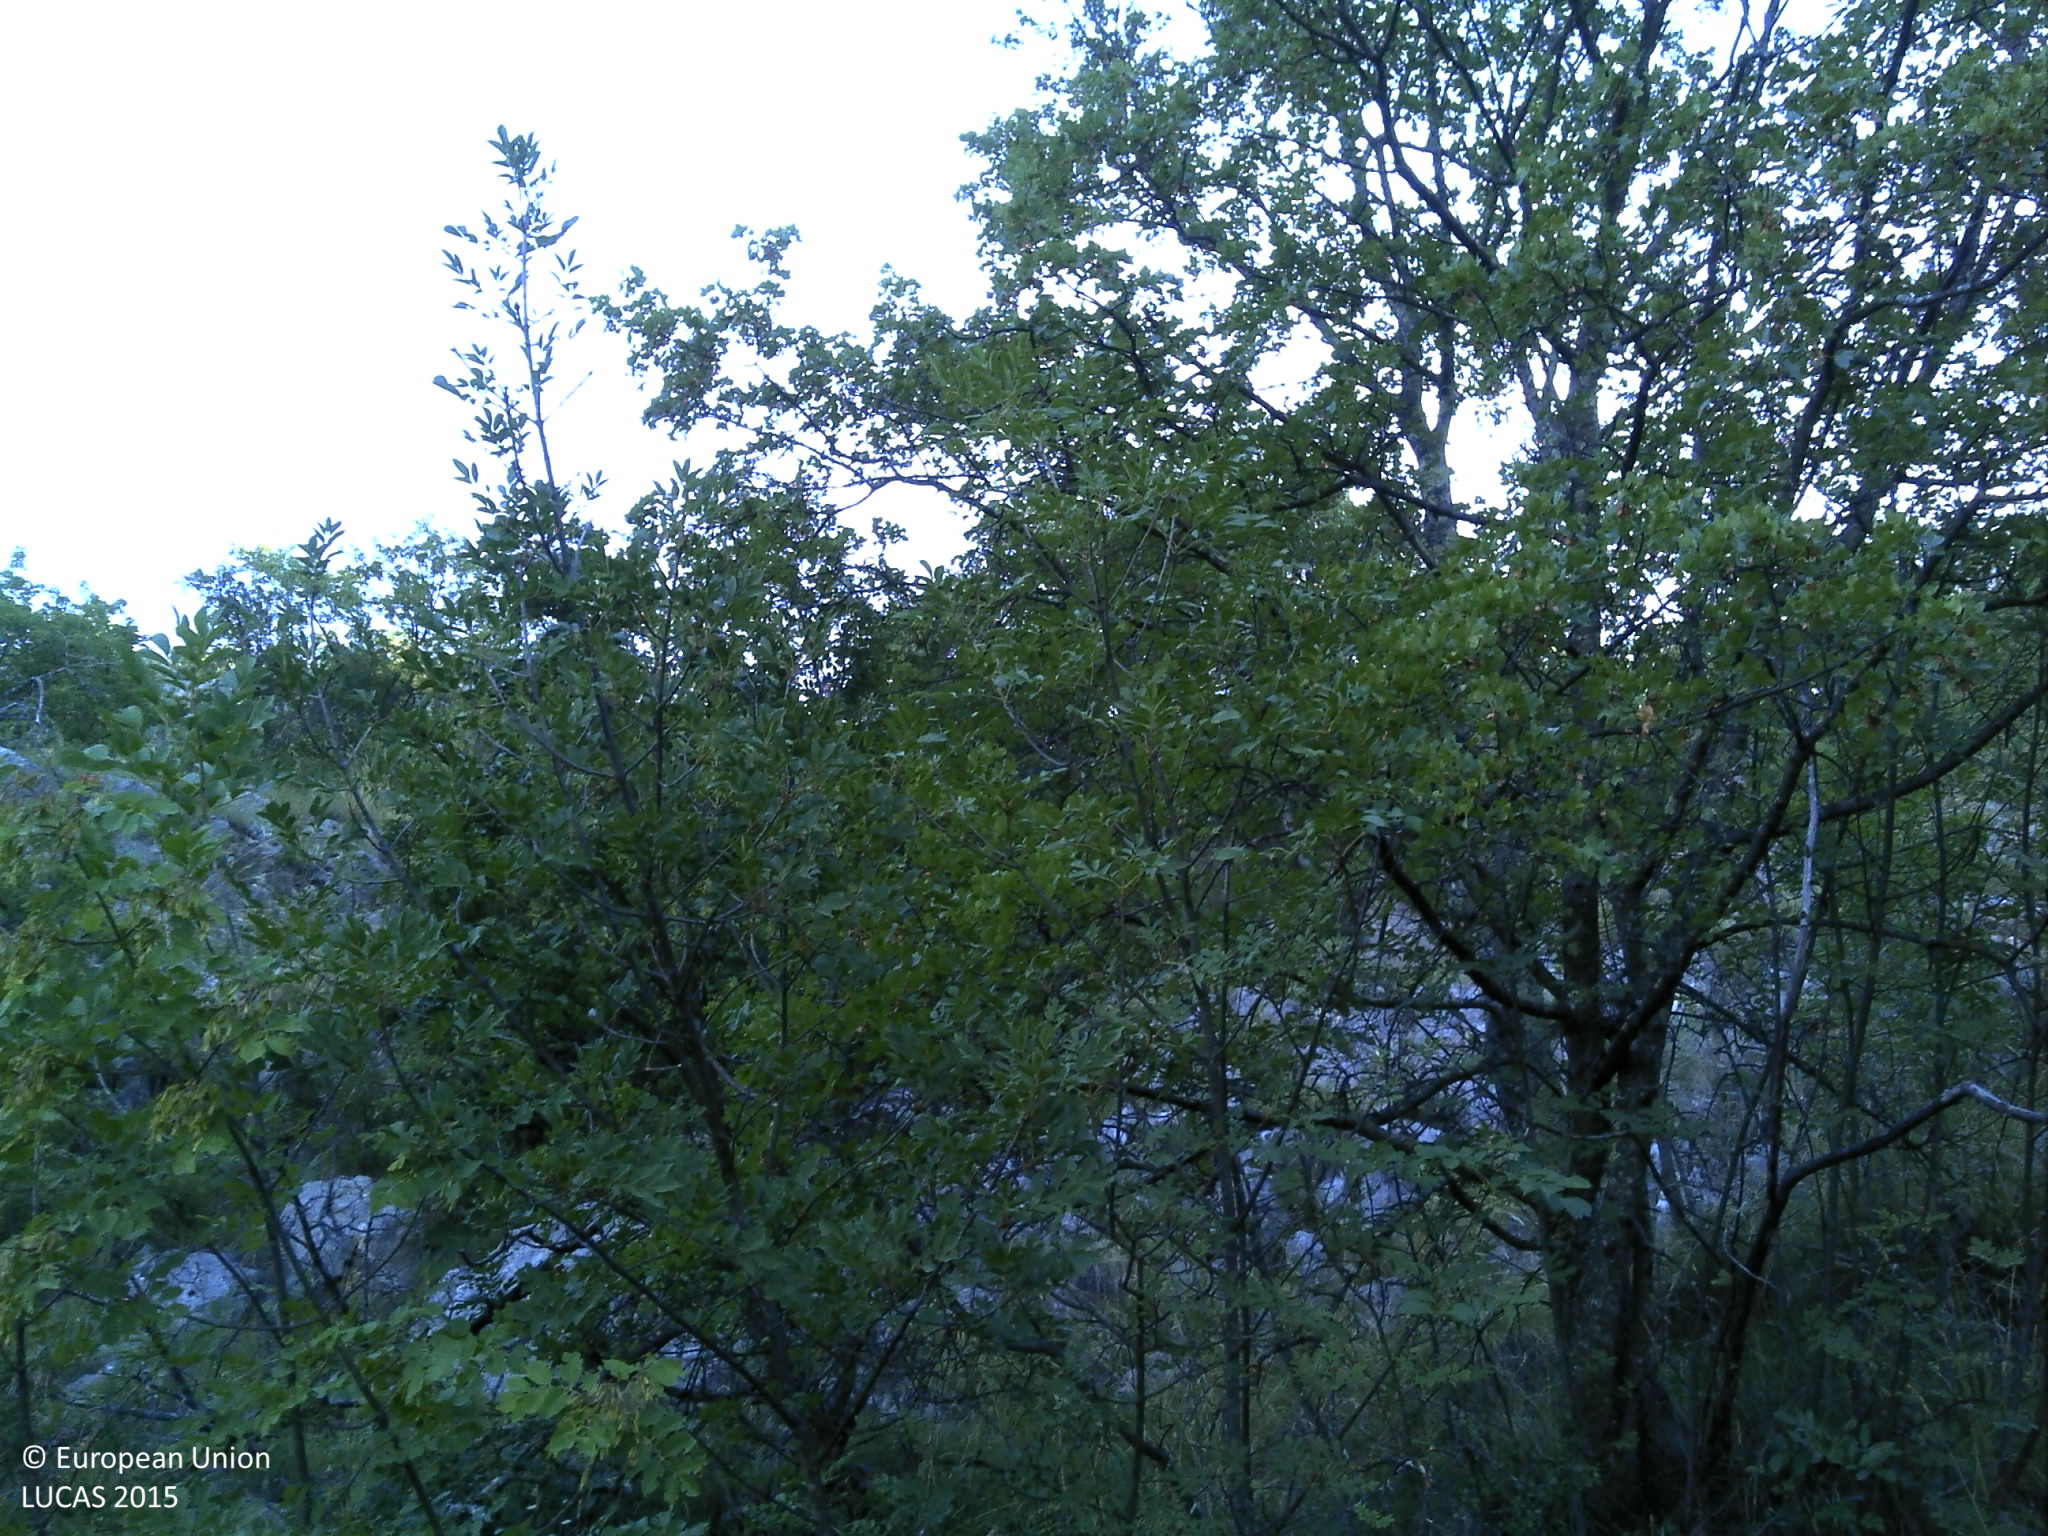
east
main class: Shrubland
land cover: Shrubland with sparse tree cover
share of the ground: 25 - 50 %
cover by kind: herbaceous plants 55 %, shrubs 25 %, unconsolidated bare surface 15 %, broadleaved forest trees 5 %
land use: Semi-natural and natural areas not in use
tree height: < 5 m
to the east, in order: Shrubland with sparse tree cover
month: June
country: HR
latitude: 44.0117
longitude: 16.0418
